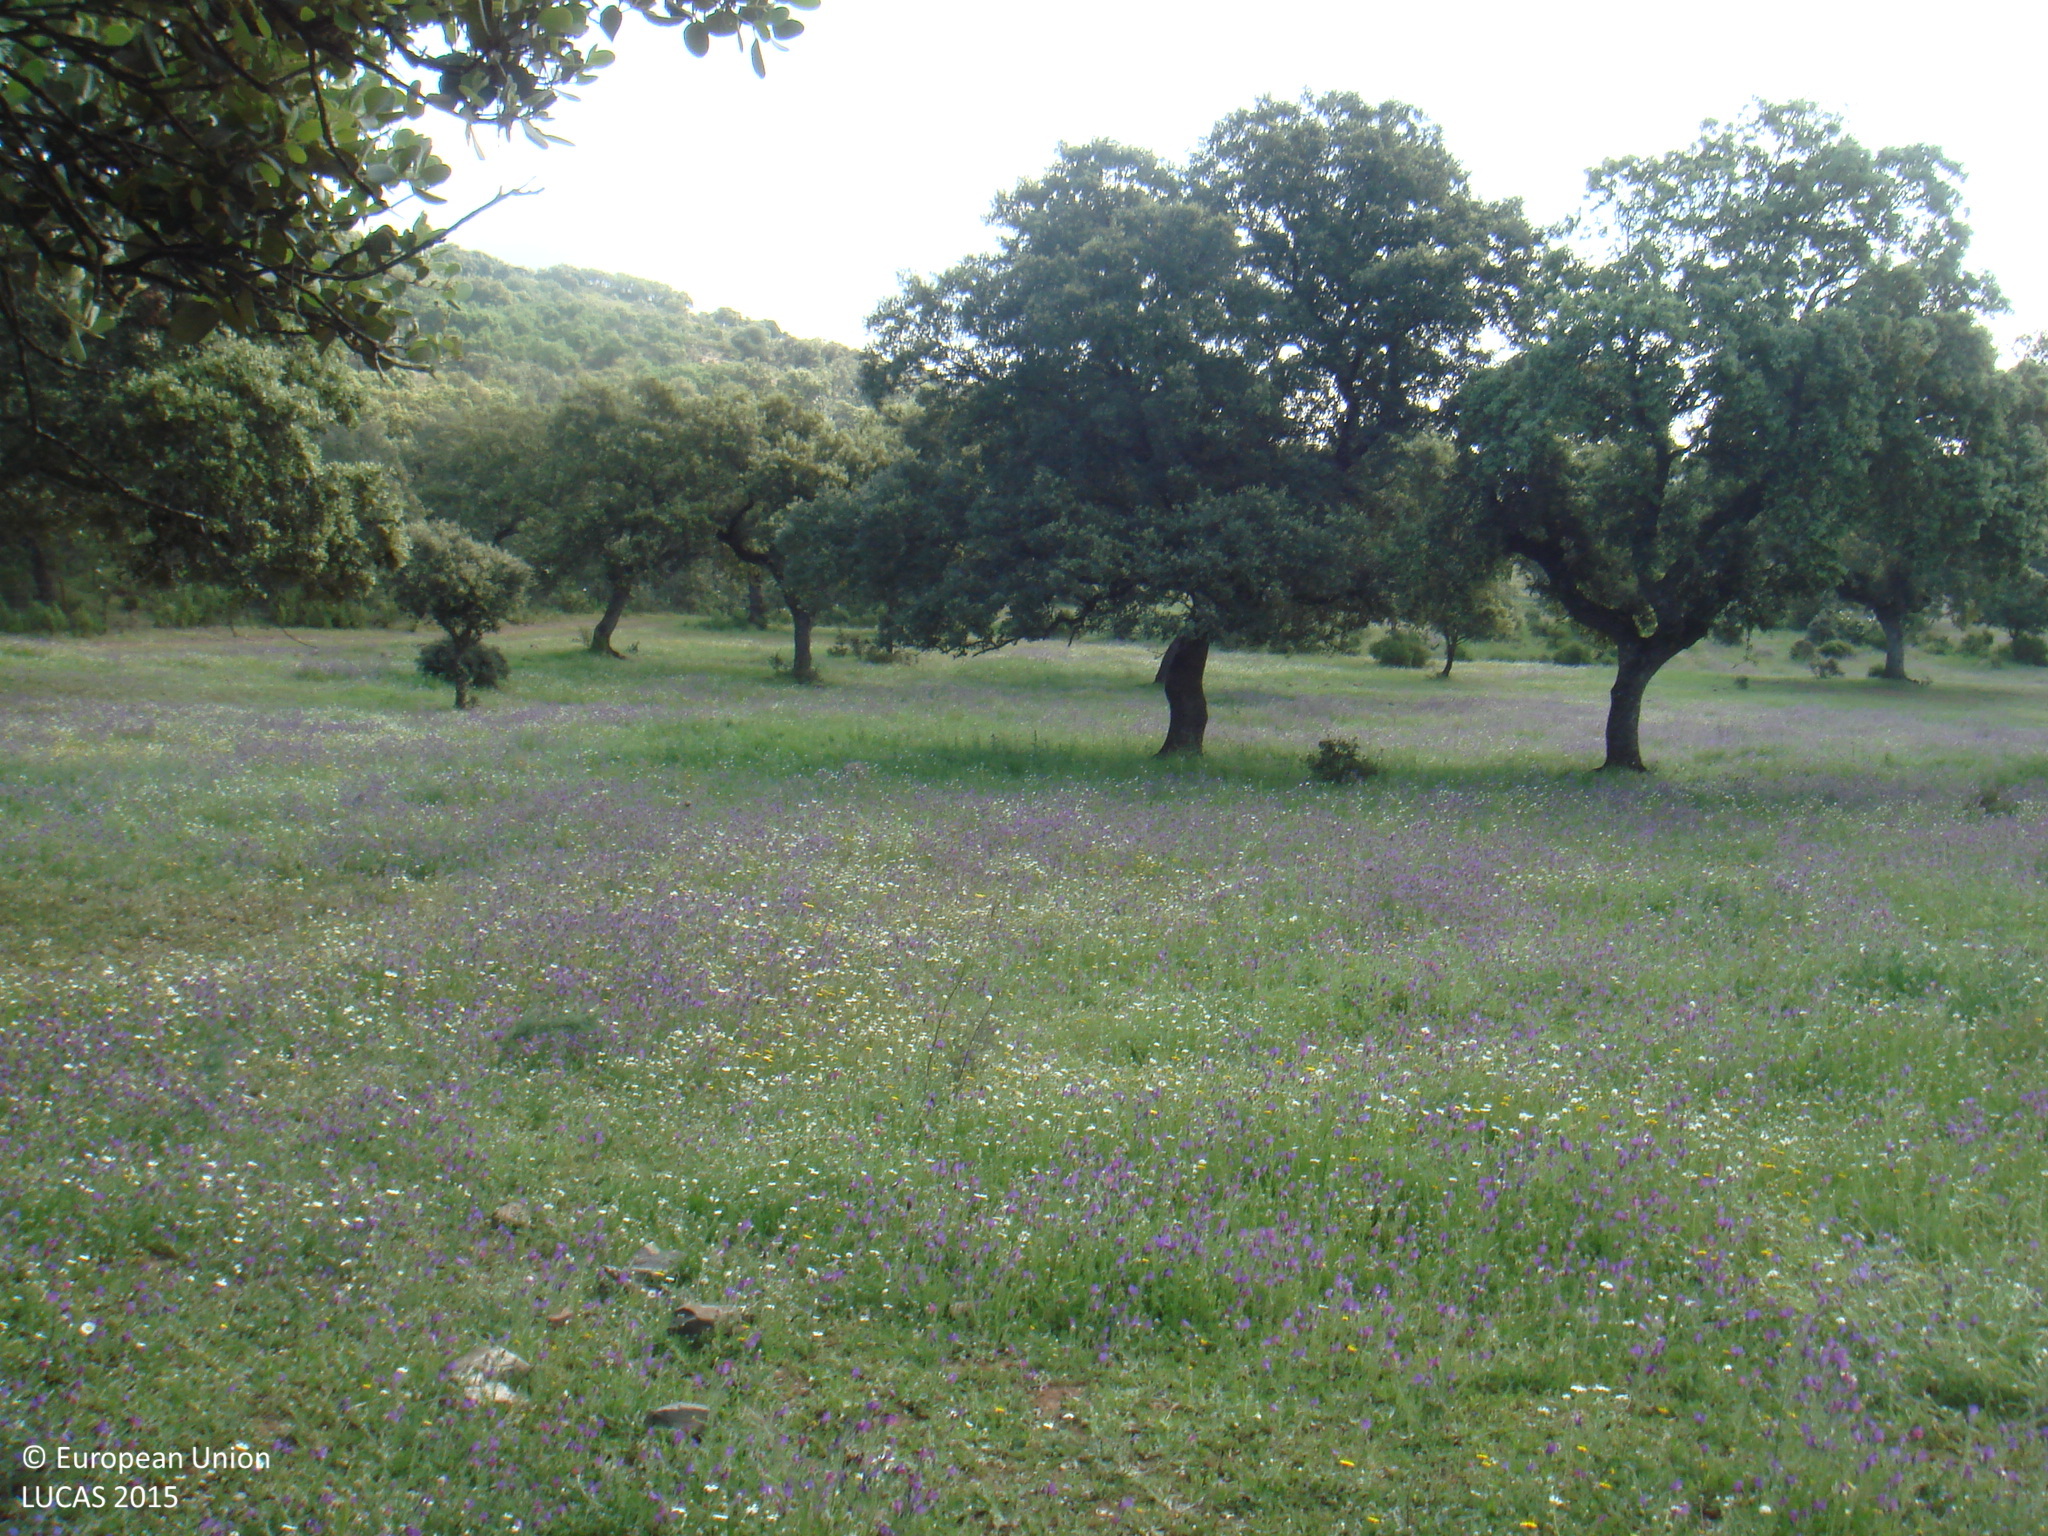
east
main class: Woodland
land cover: Broadleaved woodland
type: broadleaved evergreen forest
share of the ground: 25 - 50 %
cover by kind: herbaceous plants 60 %, broadleaved forest trees 30 %, shrubs 10 %
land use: Forestry
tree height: > 5 m
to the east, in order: Broadleaved woodland; Grassland with sparse tree/shrub cover; Broadleaved woodland; Tracks; Fences; Shrubland with sparse tree cover; Broadleaved woodland
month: April
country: ES
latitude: 38.1929
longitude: -5.0842
